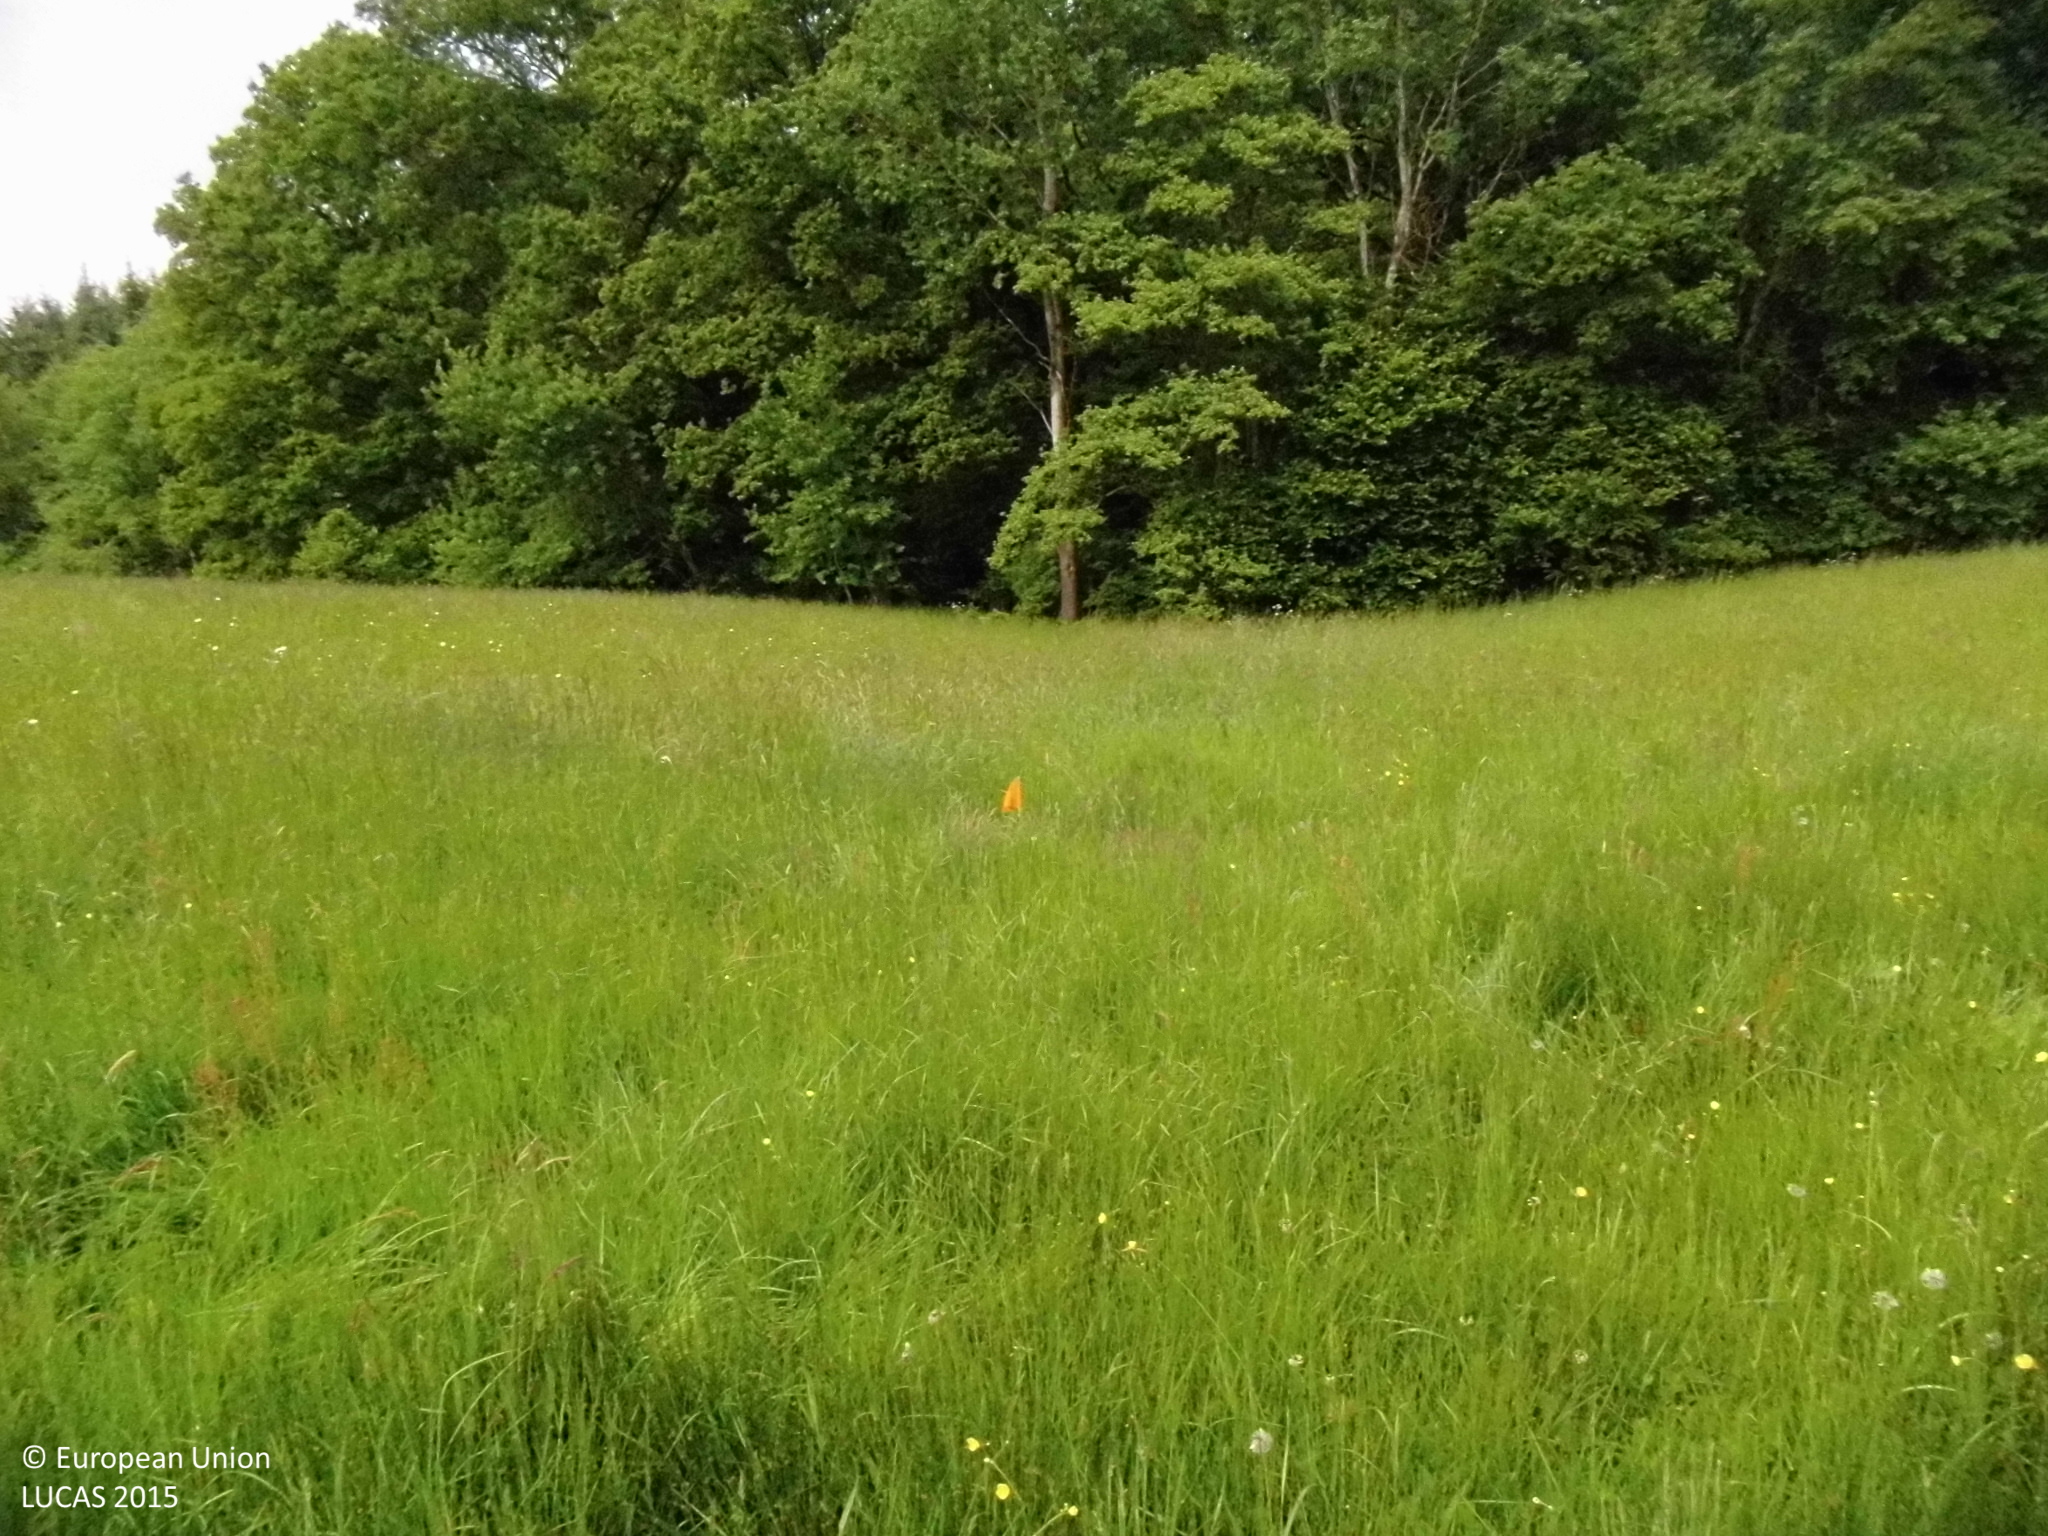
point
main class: Grassland
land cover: Grassland without tree/shrub cover
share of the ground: > 75 %
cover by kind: herbaceous plants 100 %
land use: Agriculture (excluding fallow land and kitchen gardens)
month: May
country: DE
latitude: 50.7131
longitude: 7.4368
